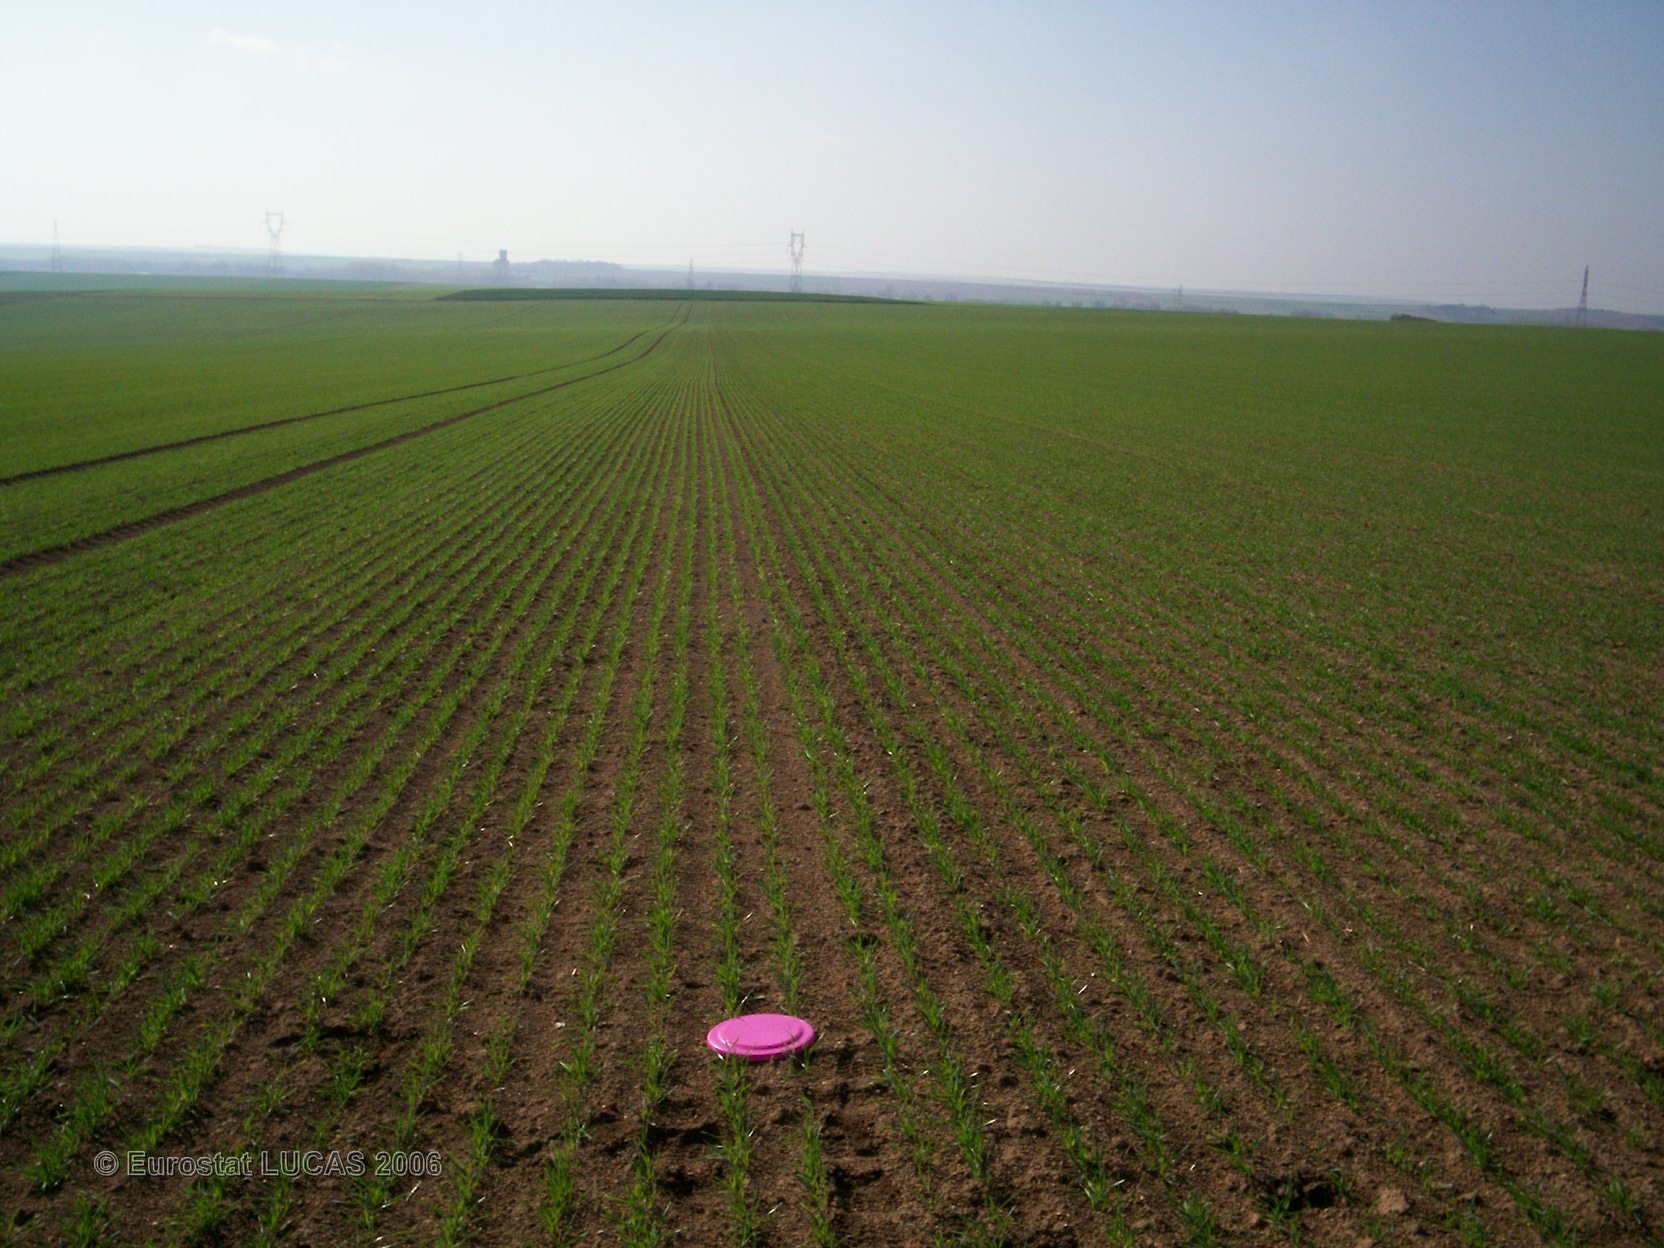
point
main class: Cropland
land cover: Barley
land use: Agriculture (excluding fallow land and kitchen gardens)
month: April
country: FR
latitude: 48.5337
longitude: 4.4310
